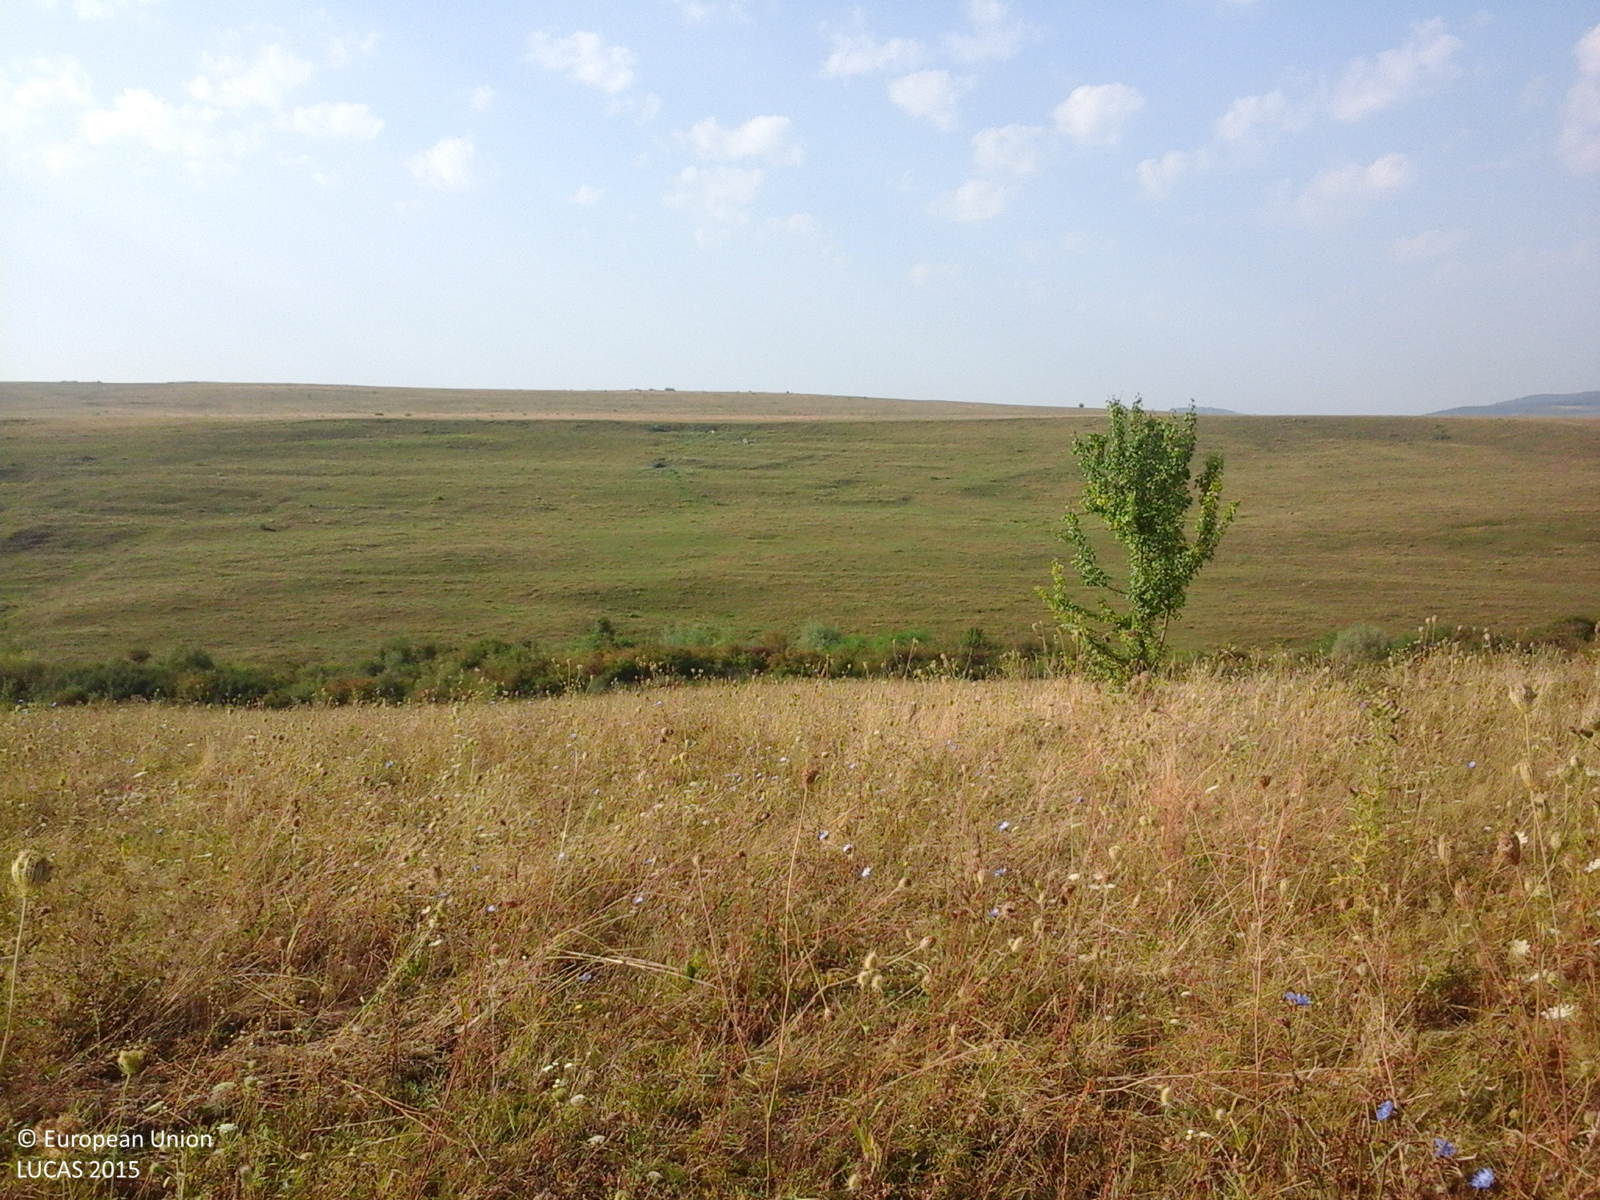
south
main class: Grassland
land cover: Grassland without tree/shrub cover
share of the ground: > 75 %
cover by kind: herbaceous plants 100 %
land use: Agriculture (excluding fallow land and kitchen gardens)
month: September
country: RO
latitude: 47.0388
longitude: 24.5014
